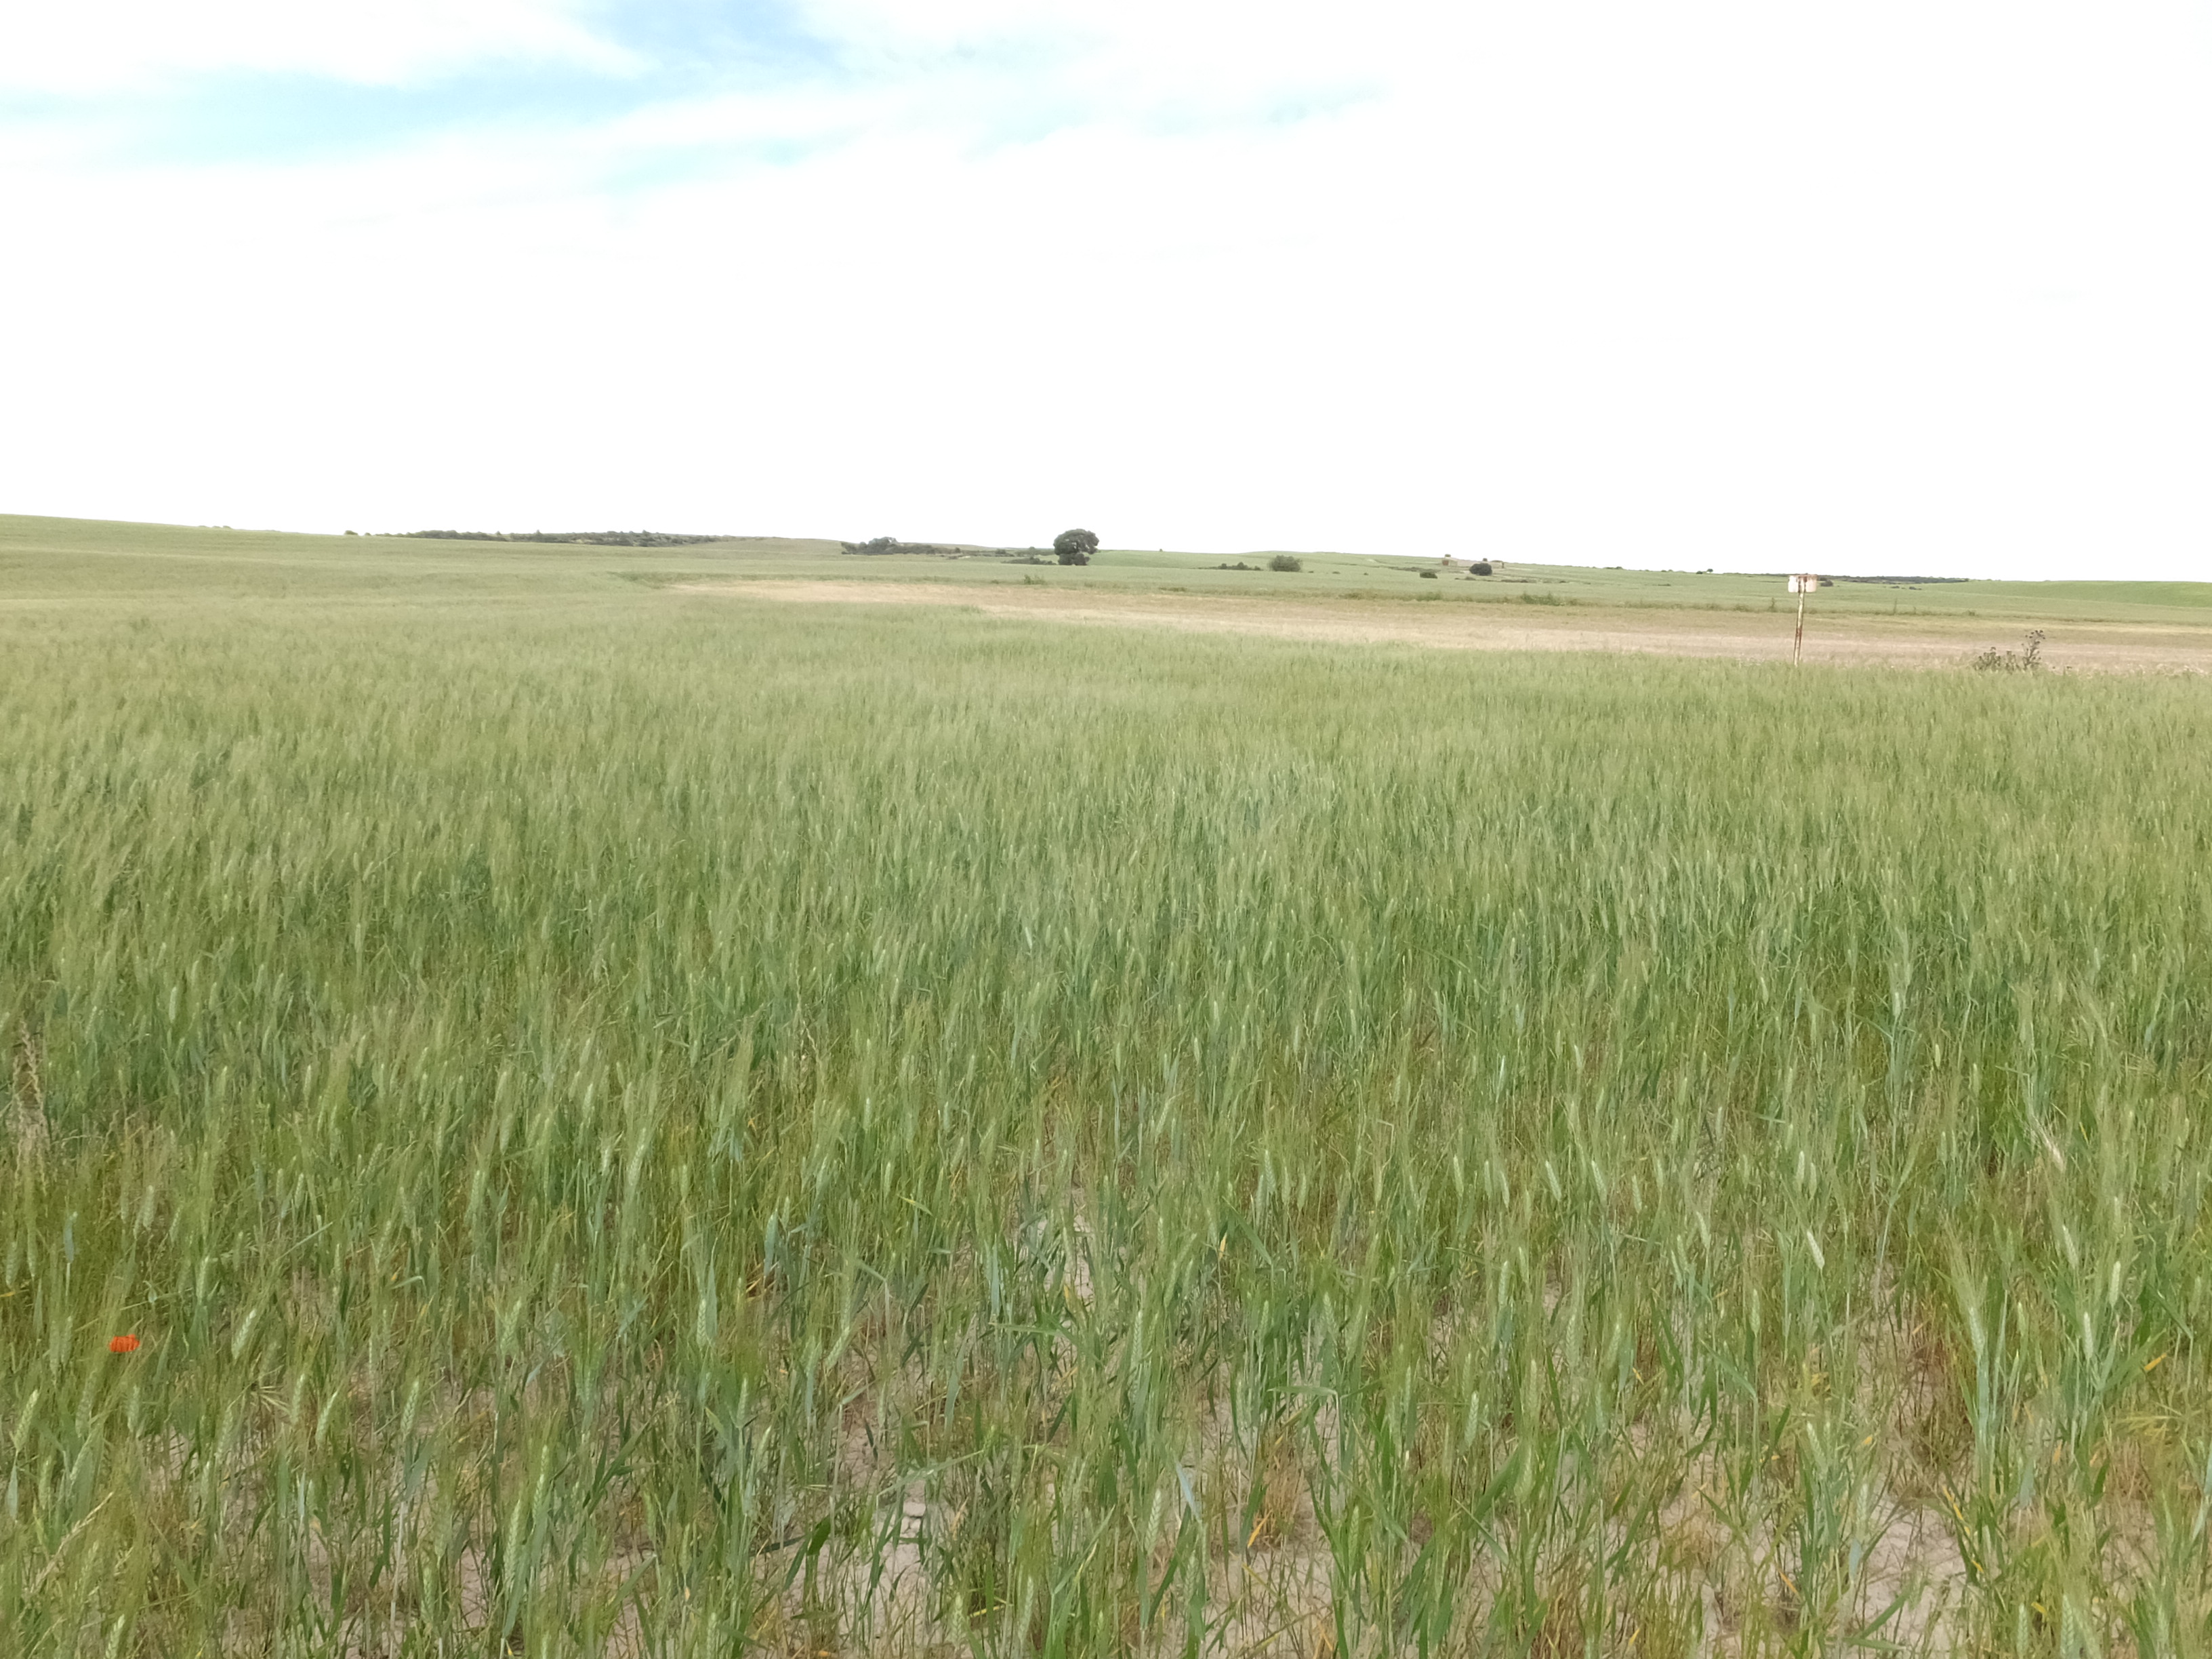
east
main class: Cropland
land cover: Durum wheat
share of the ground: > 75 %
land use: Agriculture (excluding fallow land and kitchen gardens)
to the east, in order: Durum wheat; Grass margins; Barley; Grass margins; Durum wheat; Single bushes/trees; Shrubland without tree cover; Durum wheat
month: May
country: ES
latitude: 41.6528
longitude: -0.1392
